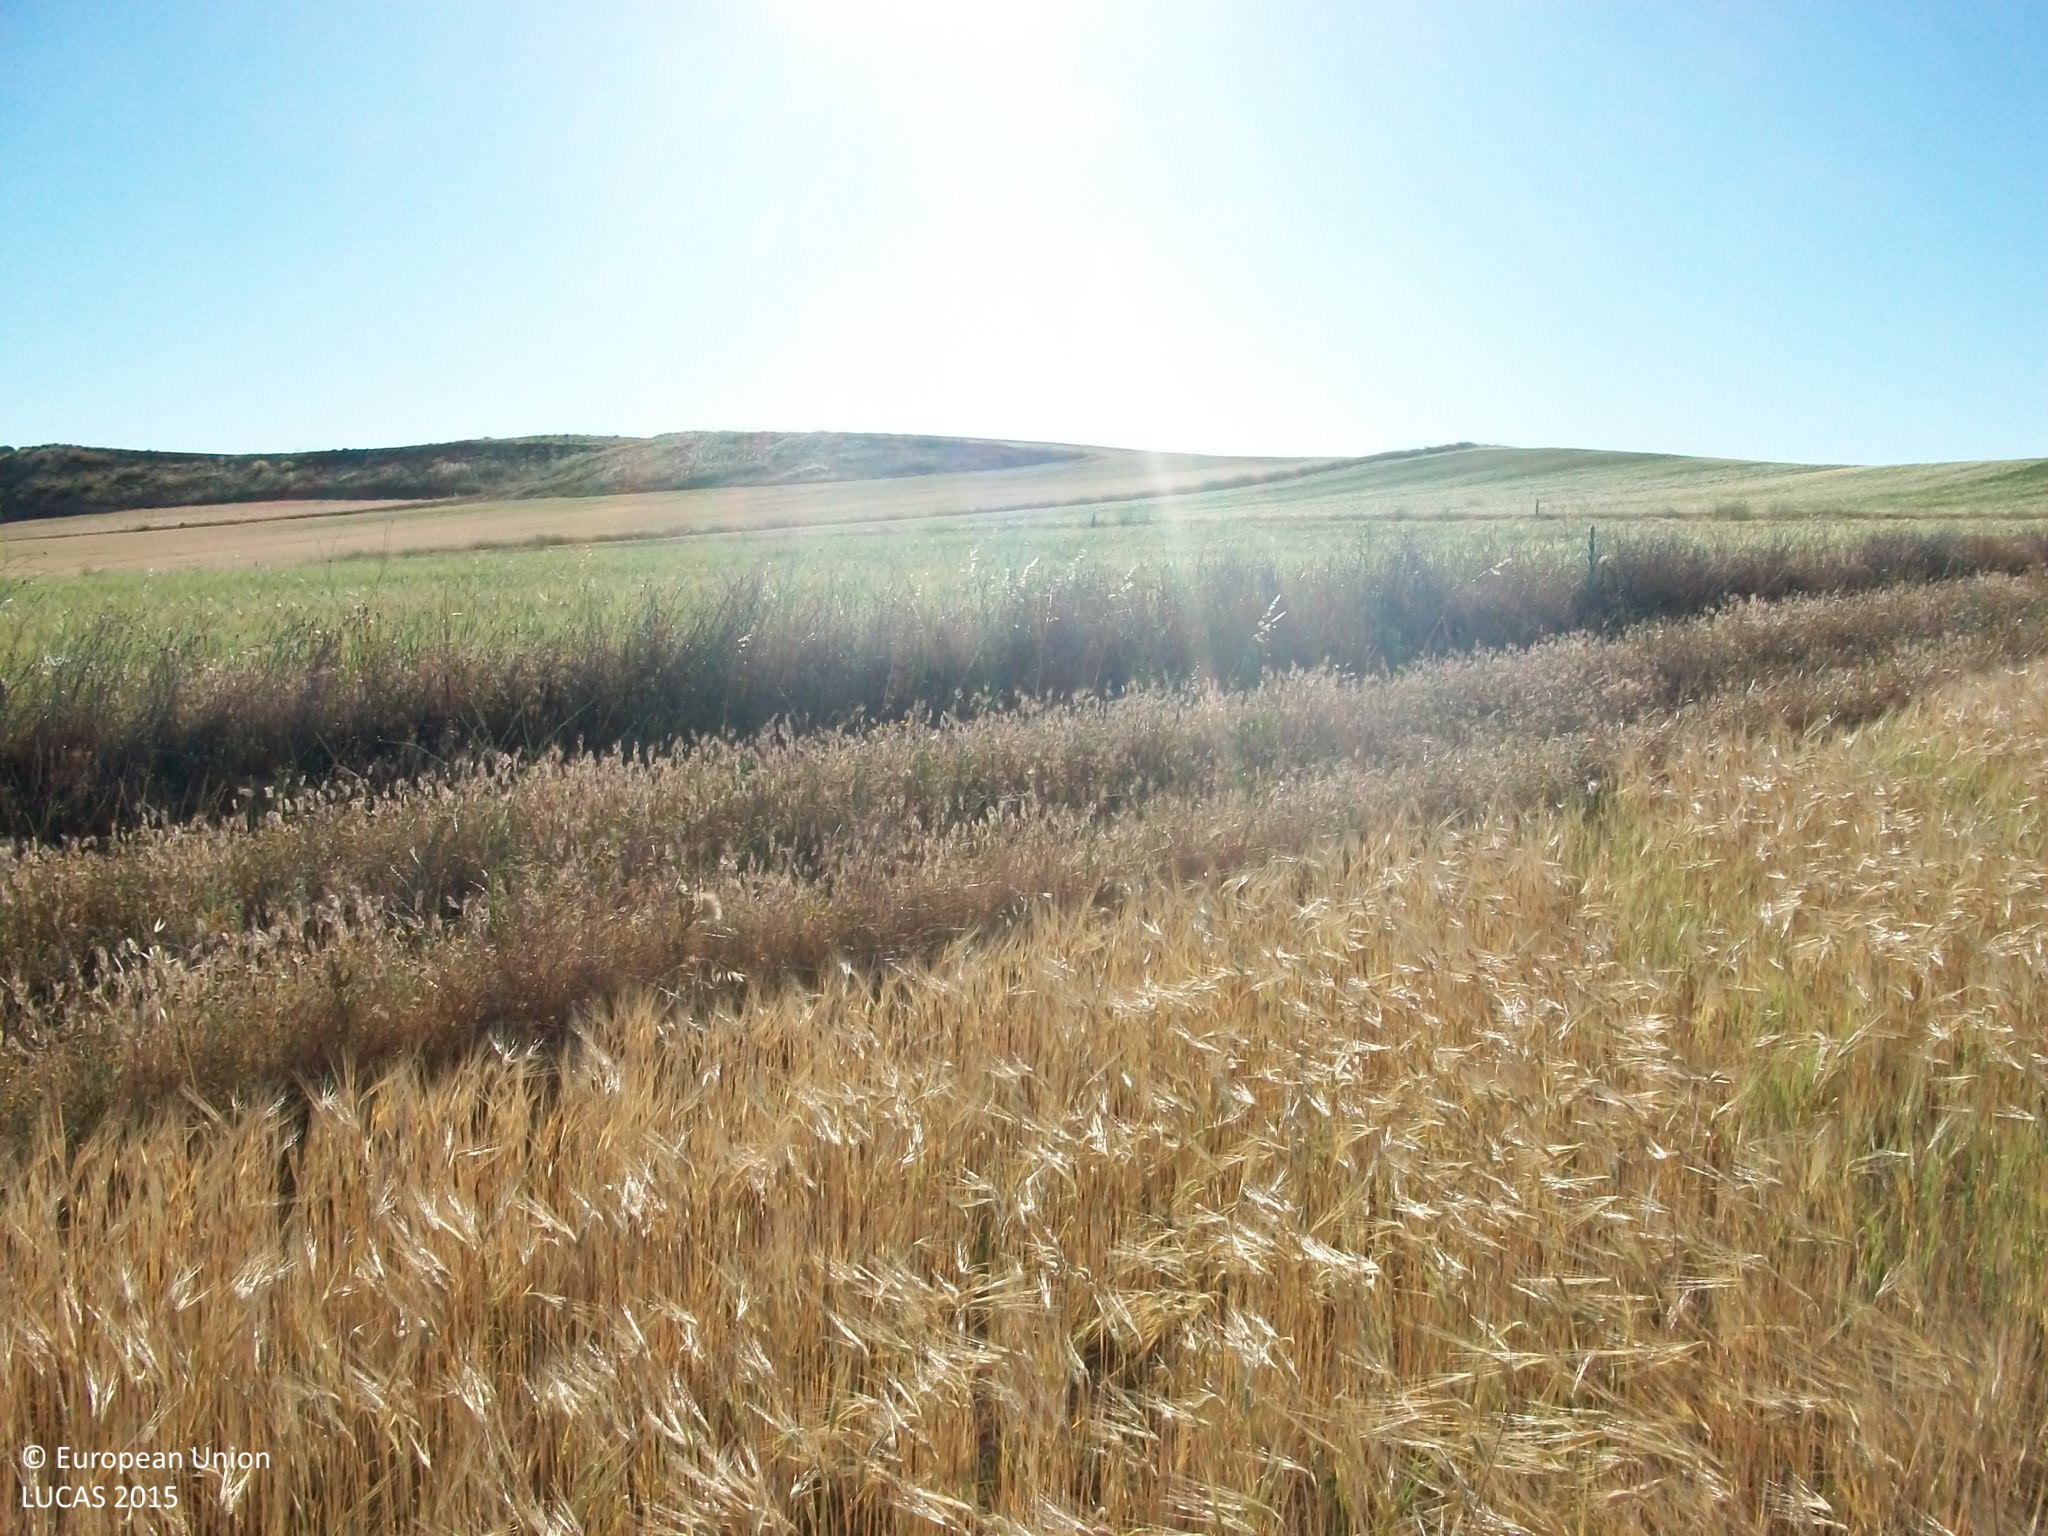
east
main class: Cropland
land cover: Barley
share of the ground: > 75 %
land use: Agriculture (excluding fallow land and kitchen gardens)
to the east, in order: Barley; Grass margins; Tracks; Grass margins; Common wheat; Grass margins; Tracks; Barley; Grass margins; Common wheat
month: May
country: ES
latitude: 39.9020
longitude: -3.7277
